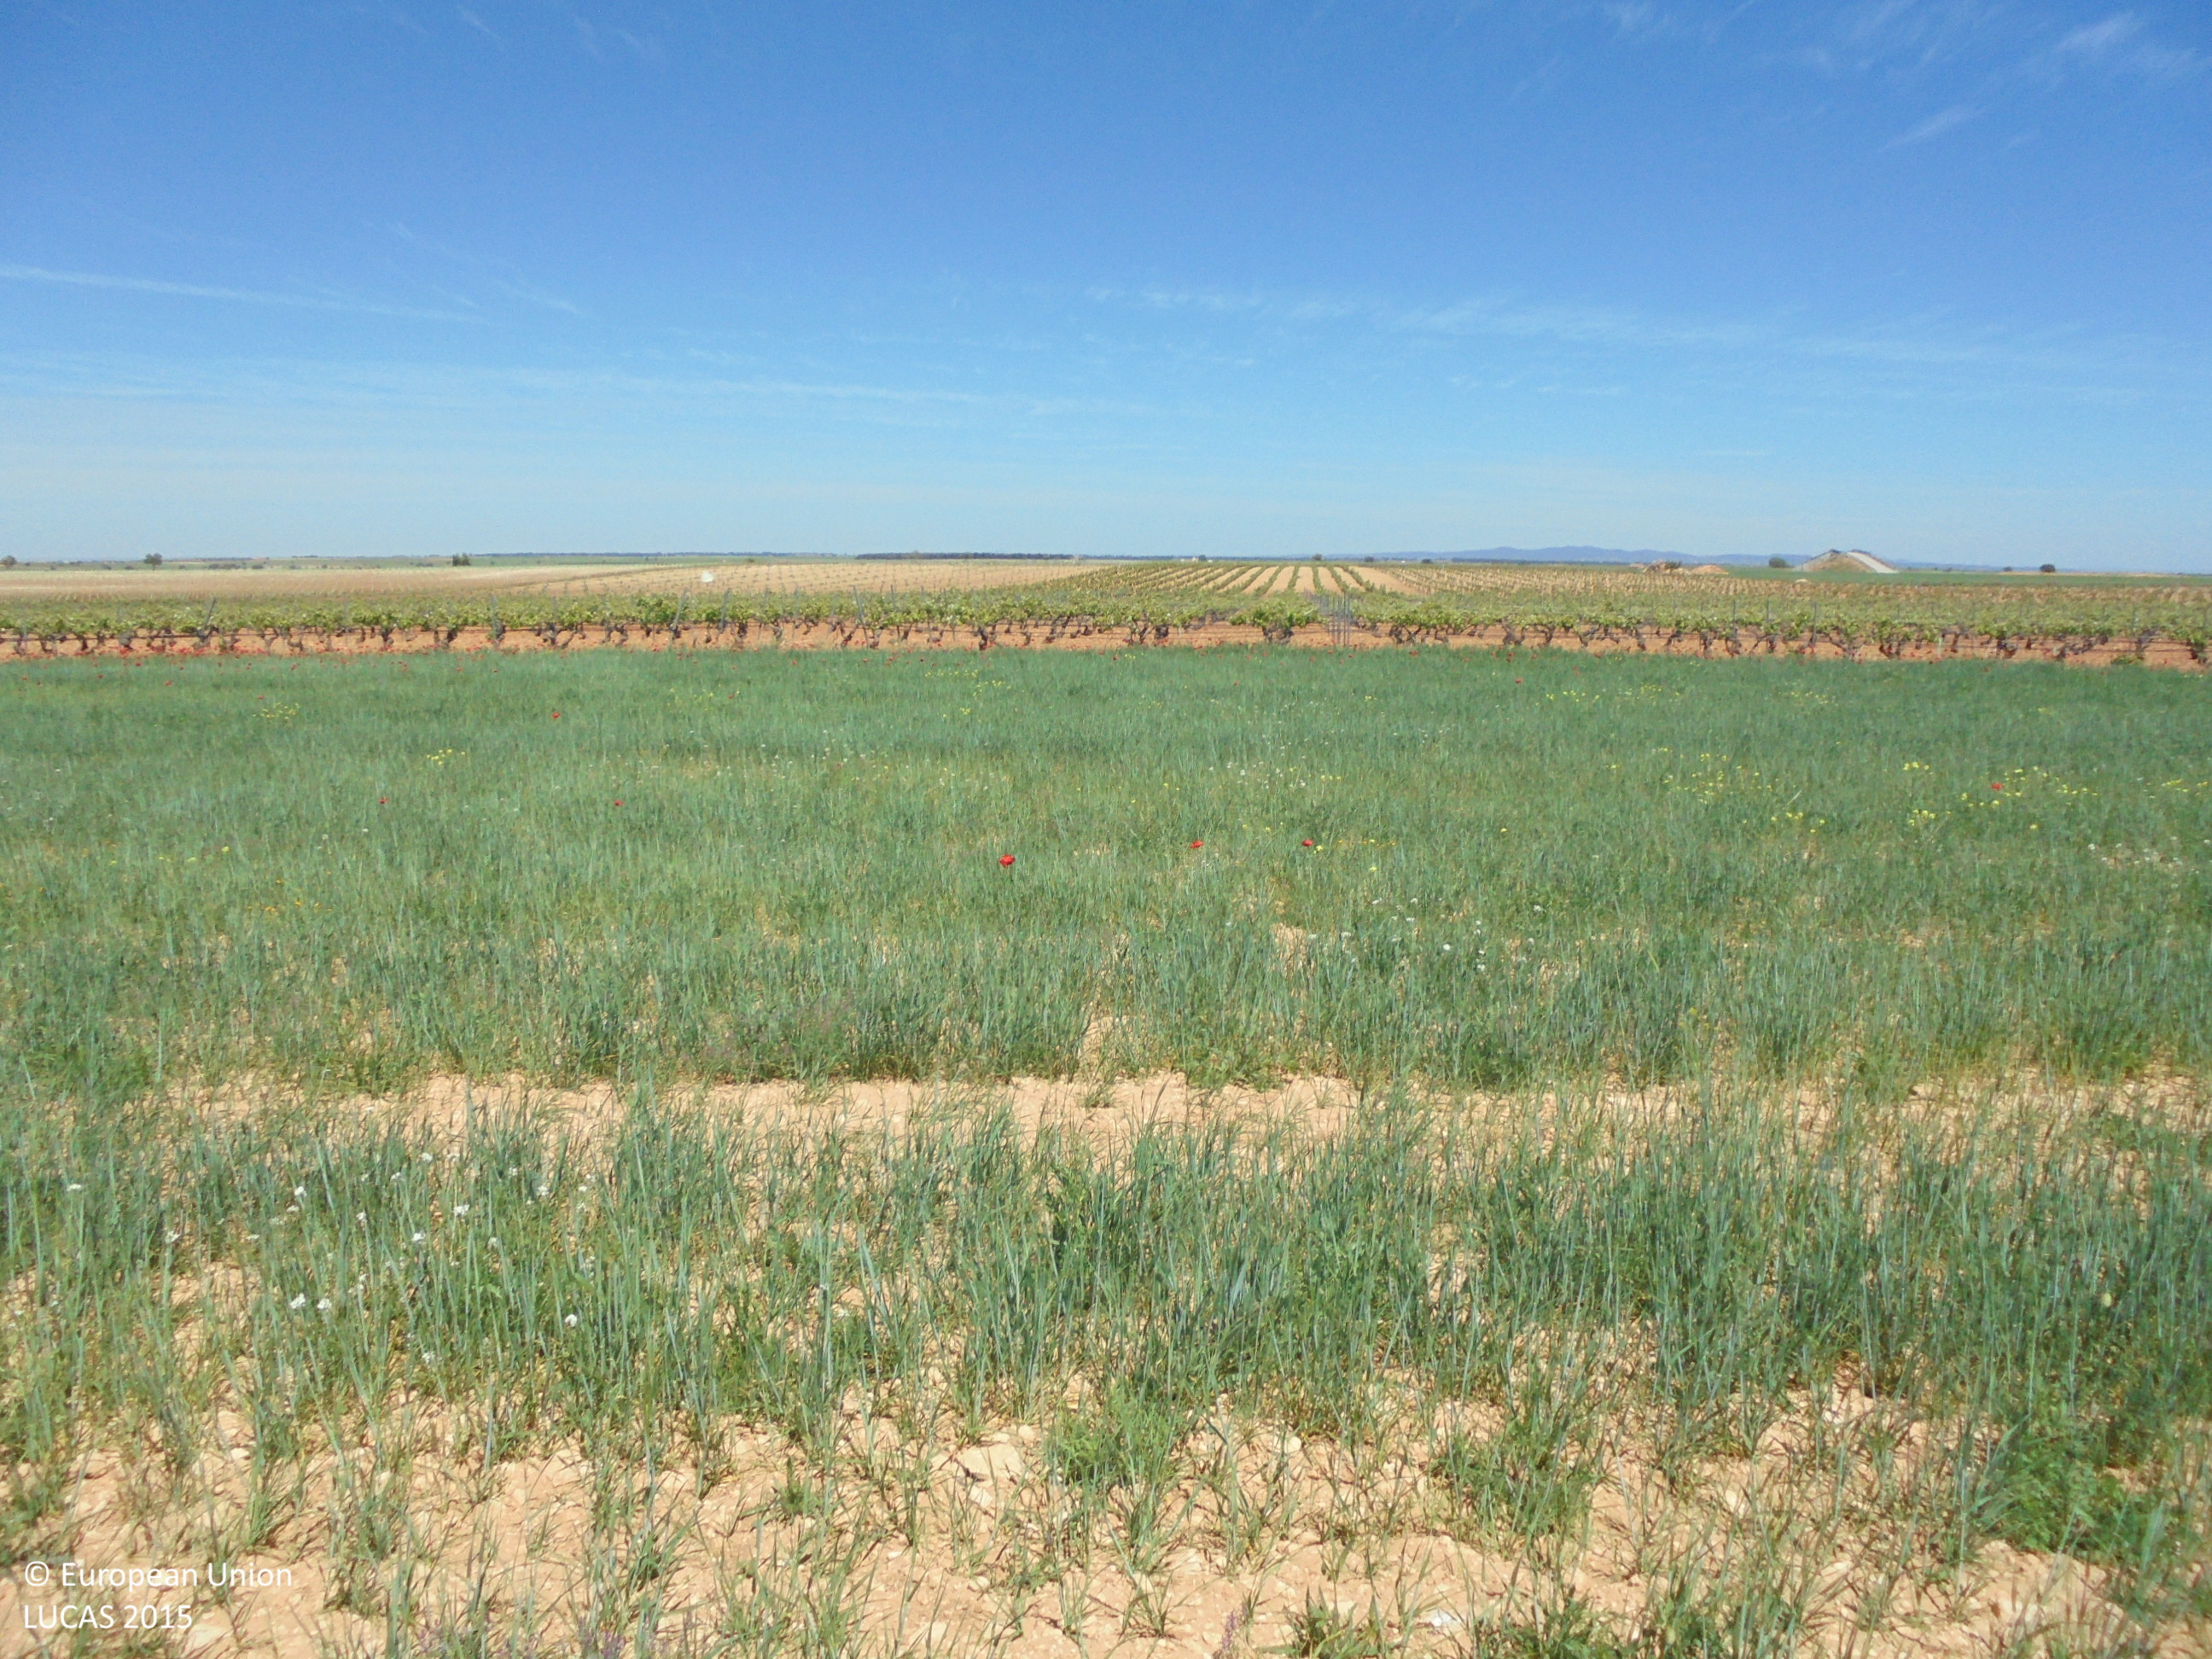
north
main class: Cropland
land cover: Barley
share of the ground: 25 - 50 %
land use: Agriculture (excluding fallow land and kitchen gardens)
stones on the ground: > 50 %
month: May
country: ES
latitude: 39.2768
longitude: -1.5123
